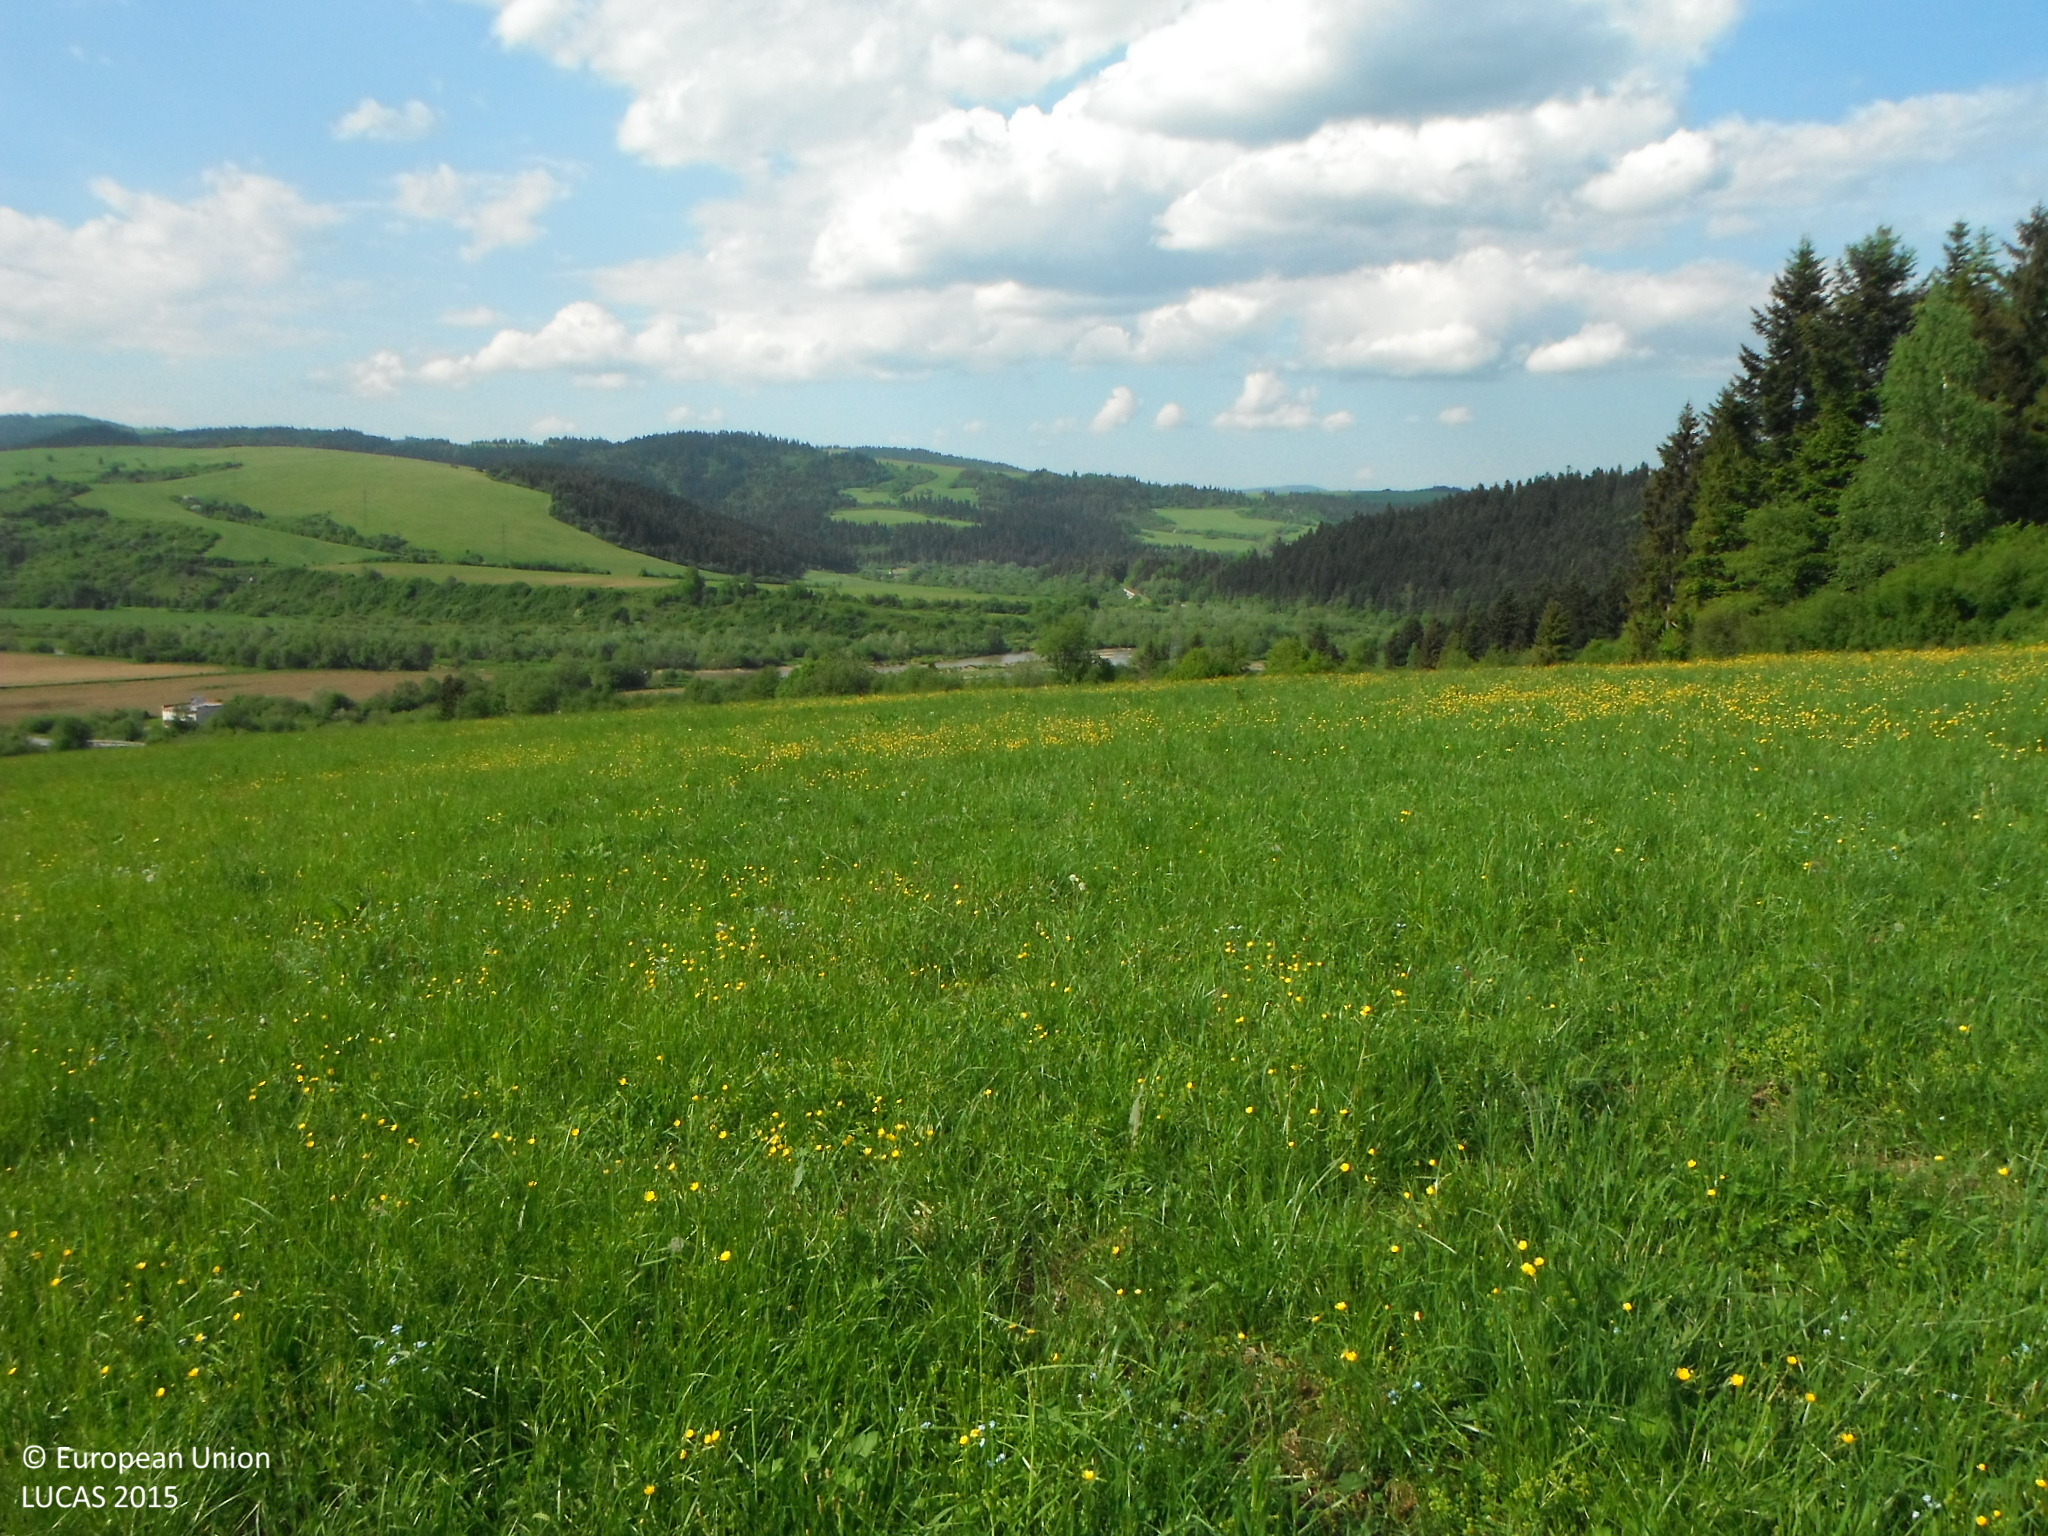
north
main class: Grassland
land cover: Grassland without tree/shrub cover
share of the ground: > 75 %
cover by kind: herbaceous plants 100 %
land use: Agriculture (excluding fallow land and kitchen gardens)
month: May
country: SK
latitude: 49.2755
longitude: 20.7468
